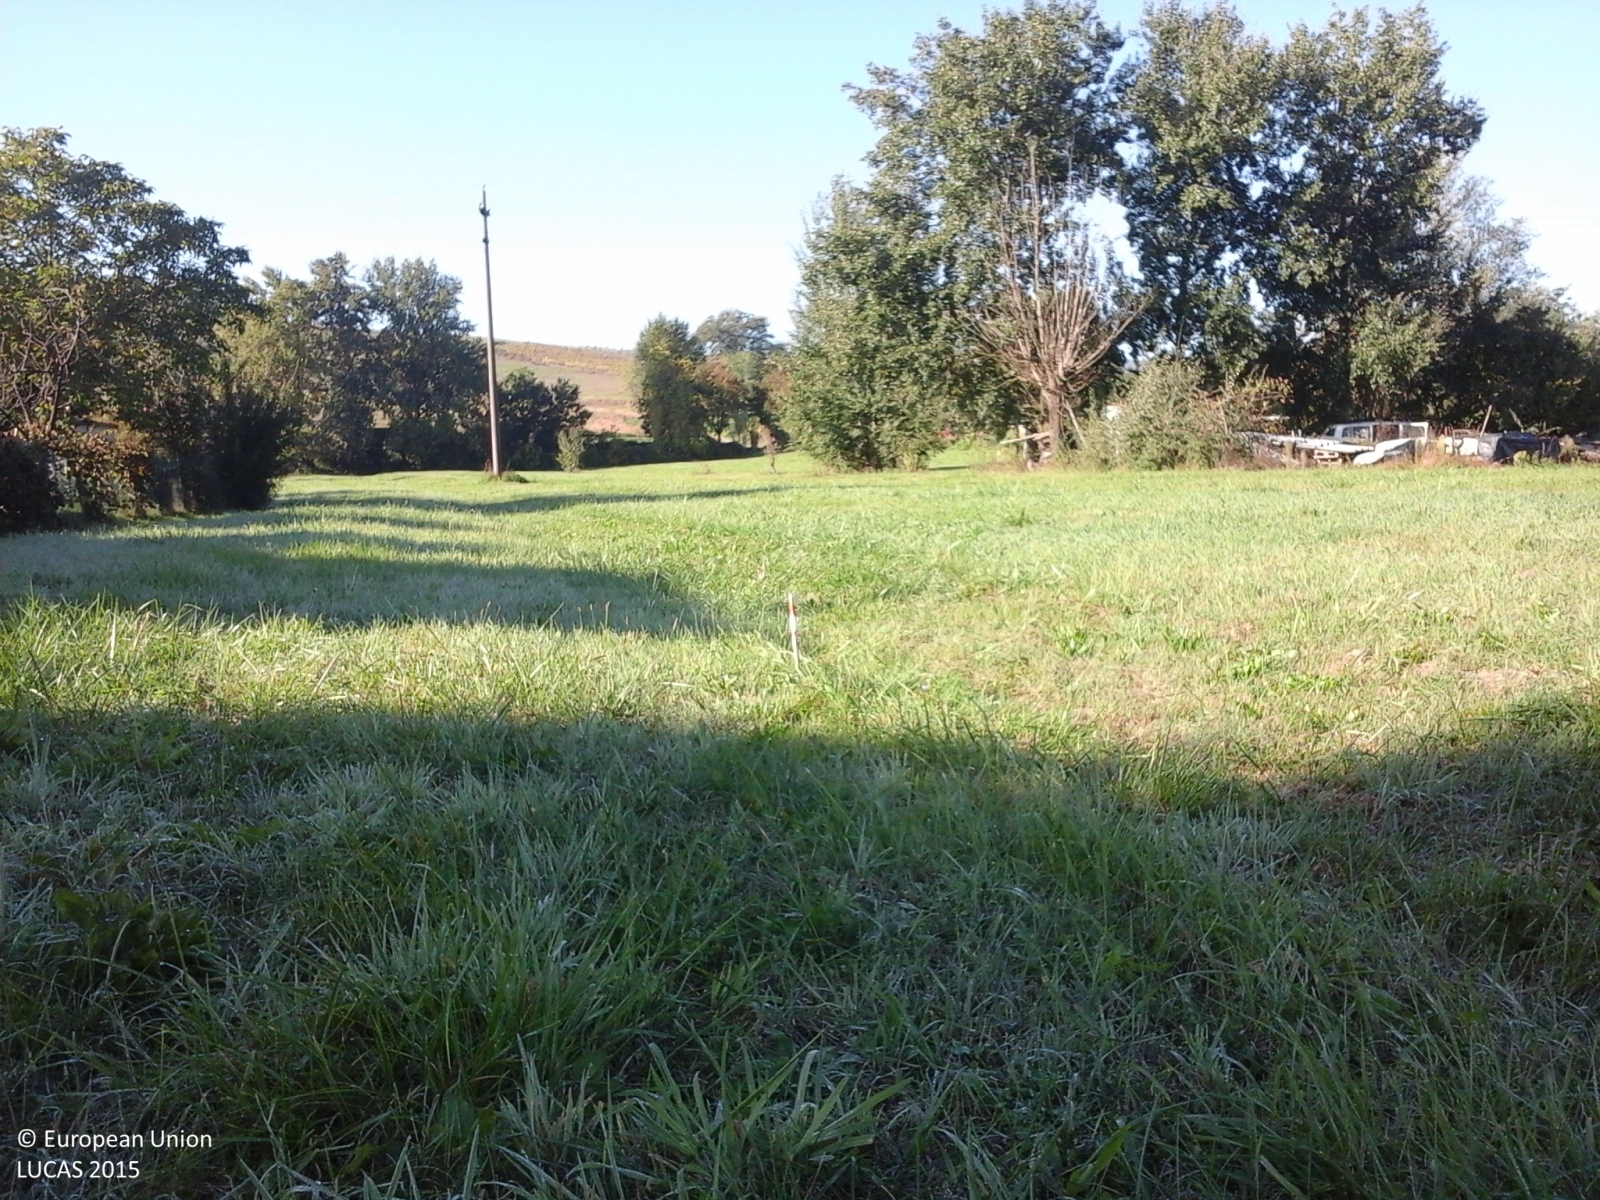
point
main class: Grassland
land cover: Grassland without tree/shrub cover
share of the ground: > 75 %
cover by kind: herbaceous plants 100 %
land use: Agriculture (excluding fallow land and kitchen gardens)
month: October
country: IT
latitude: 43.5451
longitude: 11.5429
